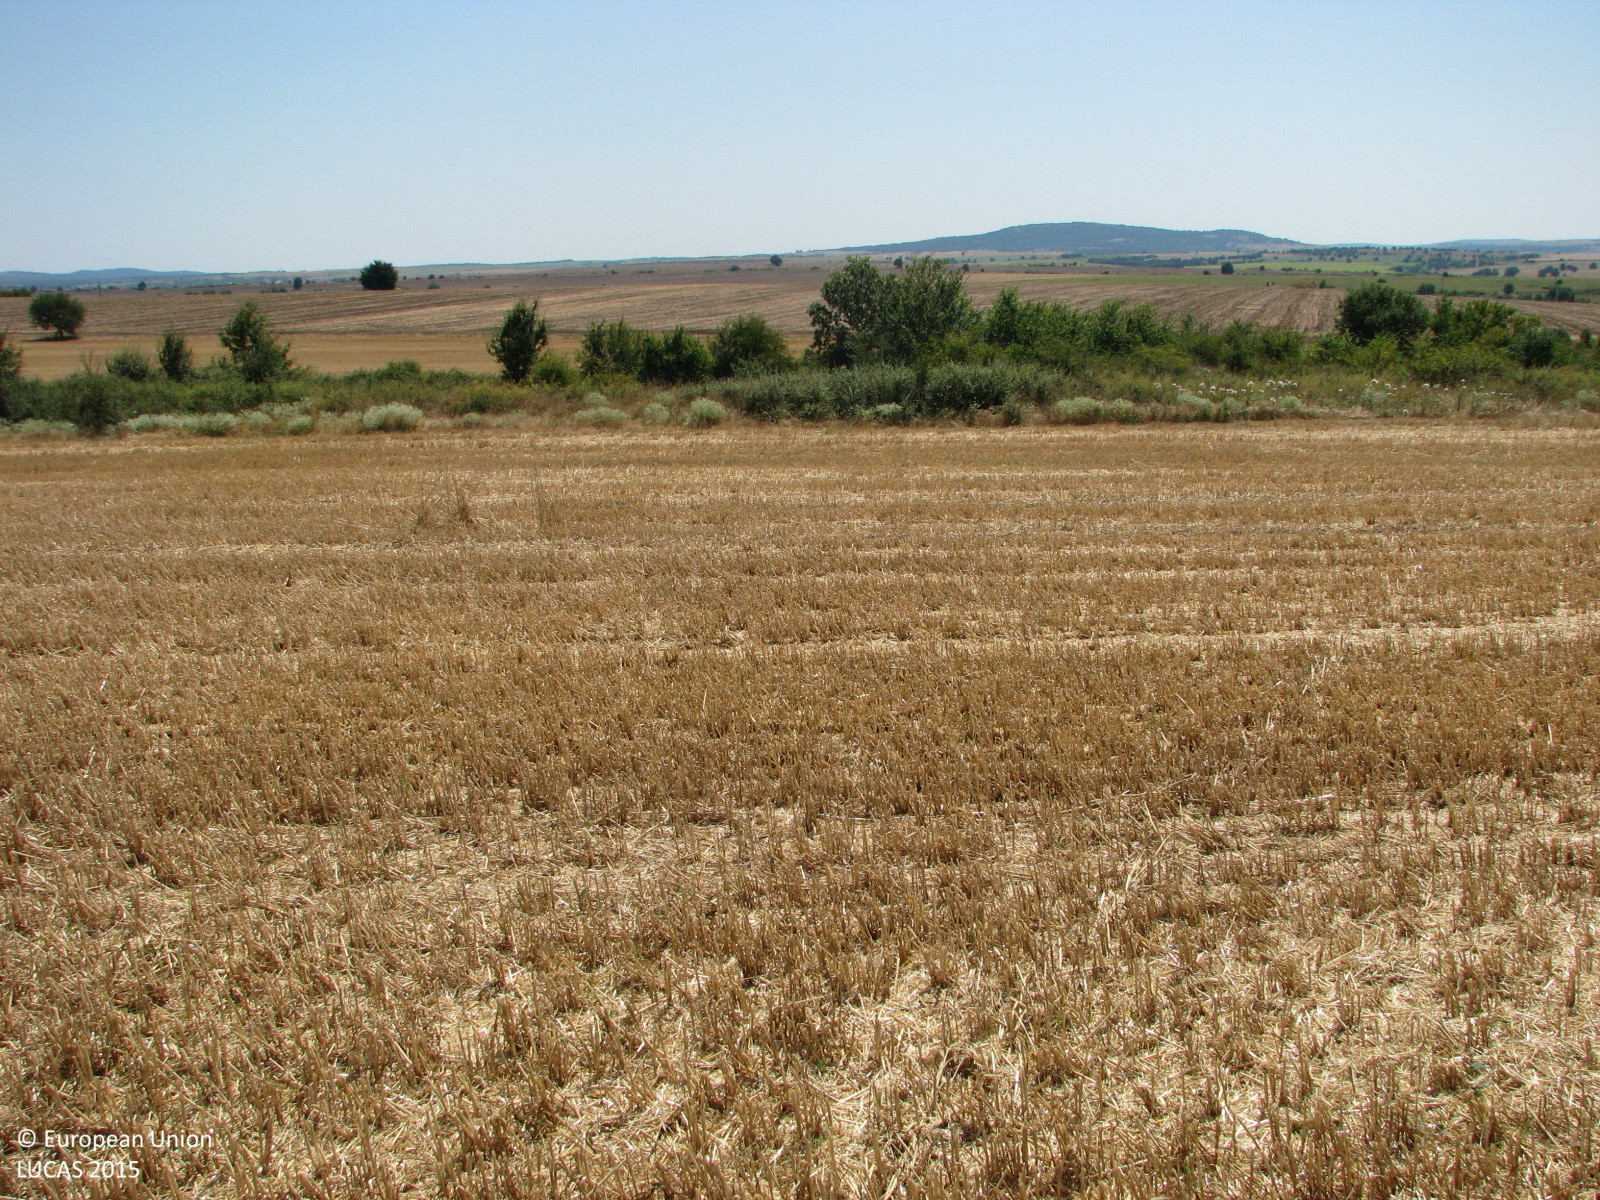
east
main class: Cropland
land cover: Common wheat
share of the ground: 25 - 50 %
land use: Agriculture (excluding fallow land and kitchen gardens)
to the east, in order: Common wheat; Grassland with sparse tree/shrub cover; Common wheat
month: July
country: BG
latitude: 42.1889
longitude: 26.8428
